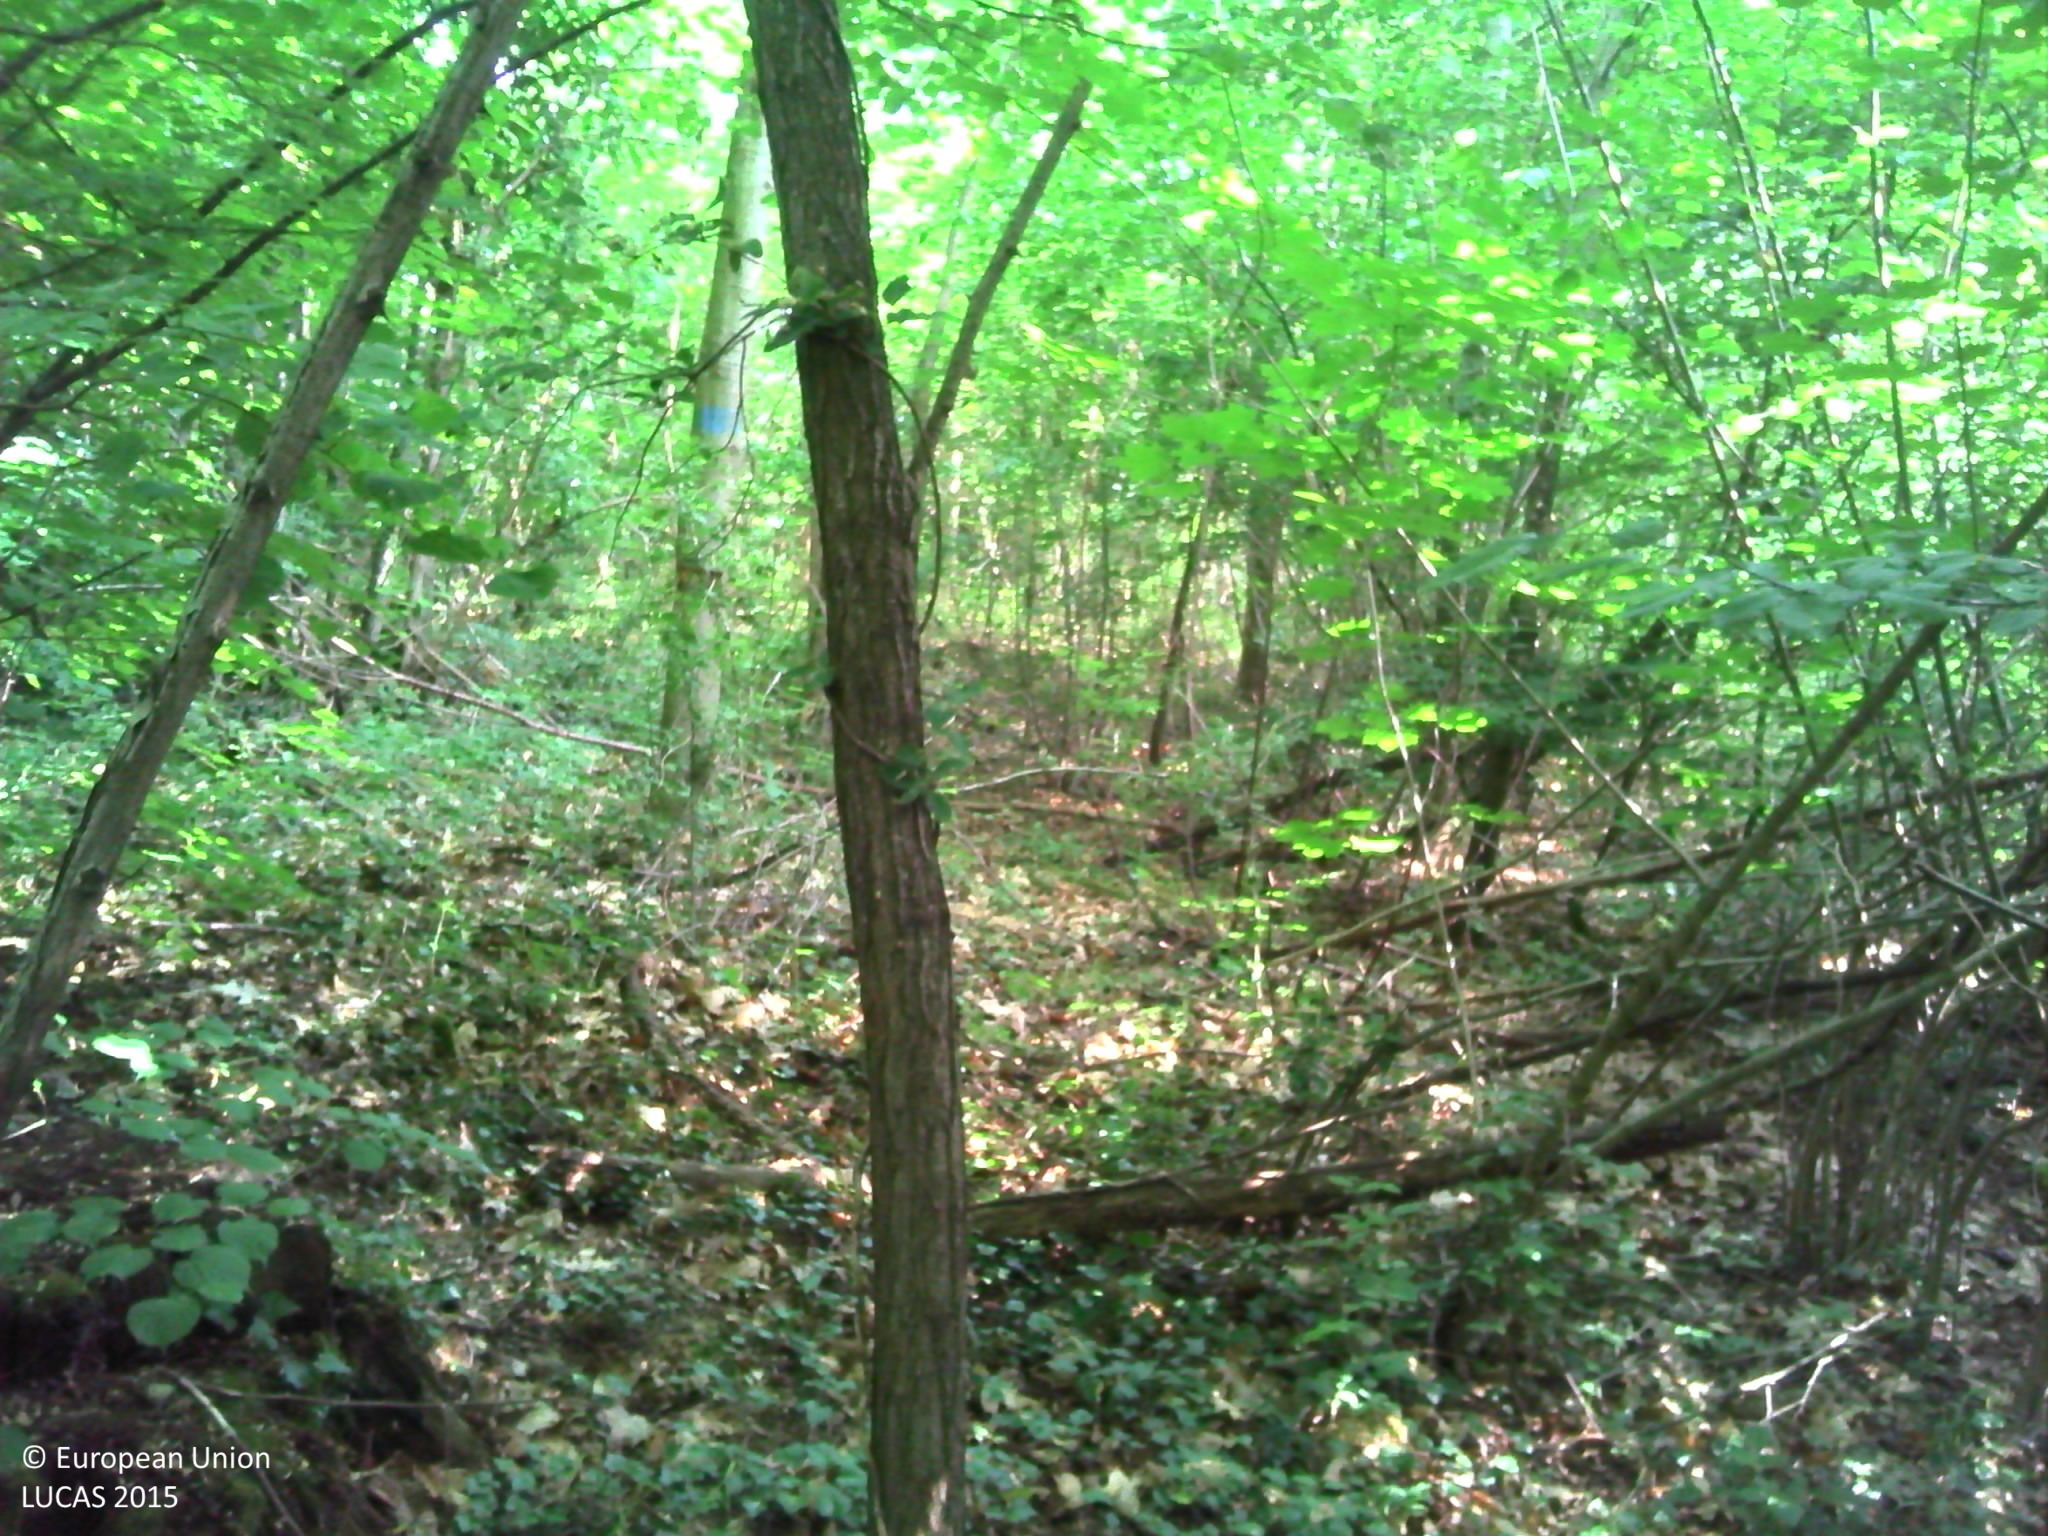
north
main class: Woodland
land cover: Broadleaved woodland
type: acidophilous oak and oak-birch forest
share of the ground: > 75 %
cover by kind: broadleaved forest trees 85 %, herbaceous plants 15 %
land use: Forestry
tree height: > 5 m
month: June
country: FR
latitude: 46.1004
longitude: 4.8414
